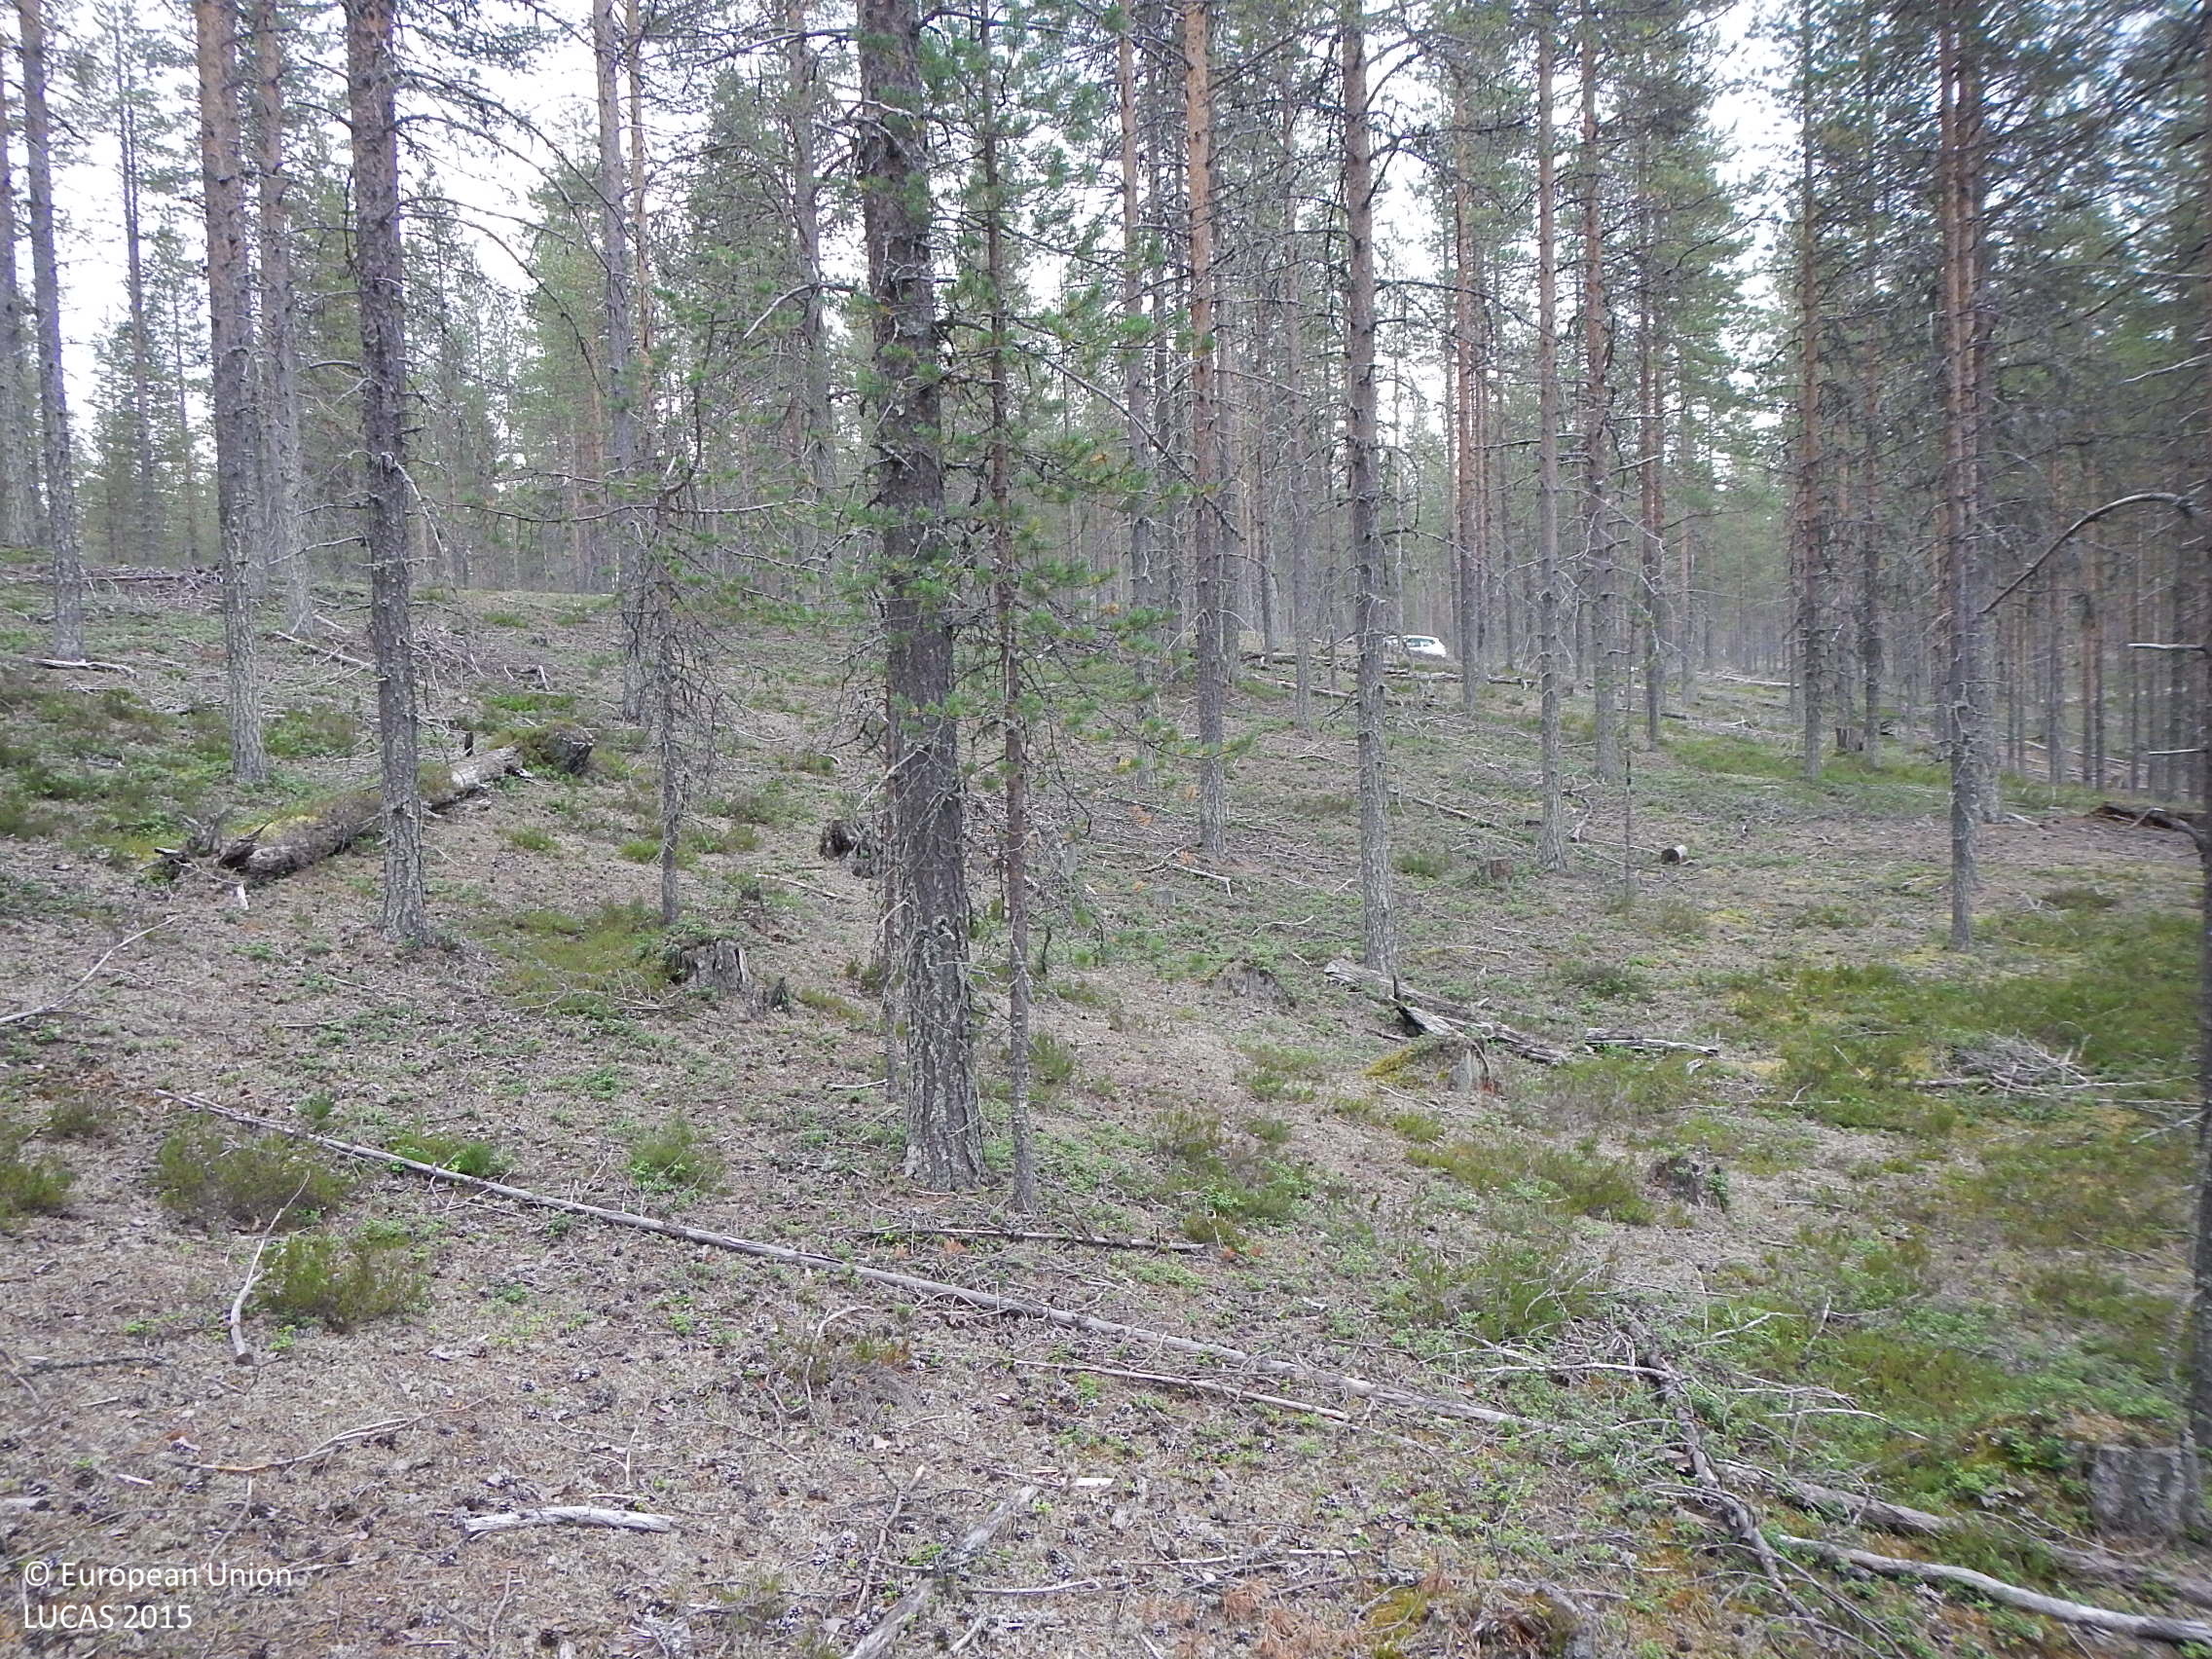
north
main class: Woodland
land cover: Pine dominated coniferous woodland
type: boreal forest
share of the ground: 50 - 75 %
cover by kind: coniferous forest trees 60 %, shrubs 30 %, lichens and mosses 10 %
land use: Forestry
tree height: > 5 m
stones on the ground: < 10 %
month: August
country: FI
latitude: 66.0489
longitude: 27.7676
